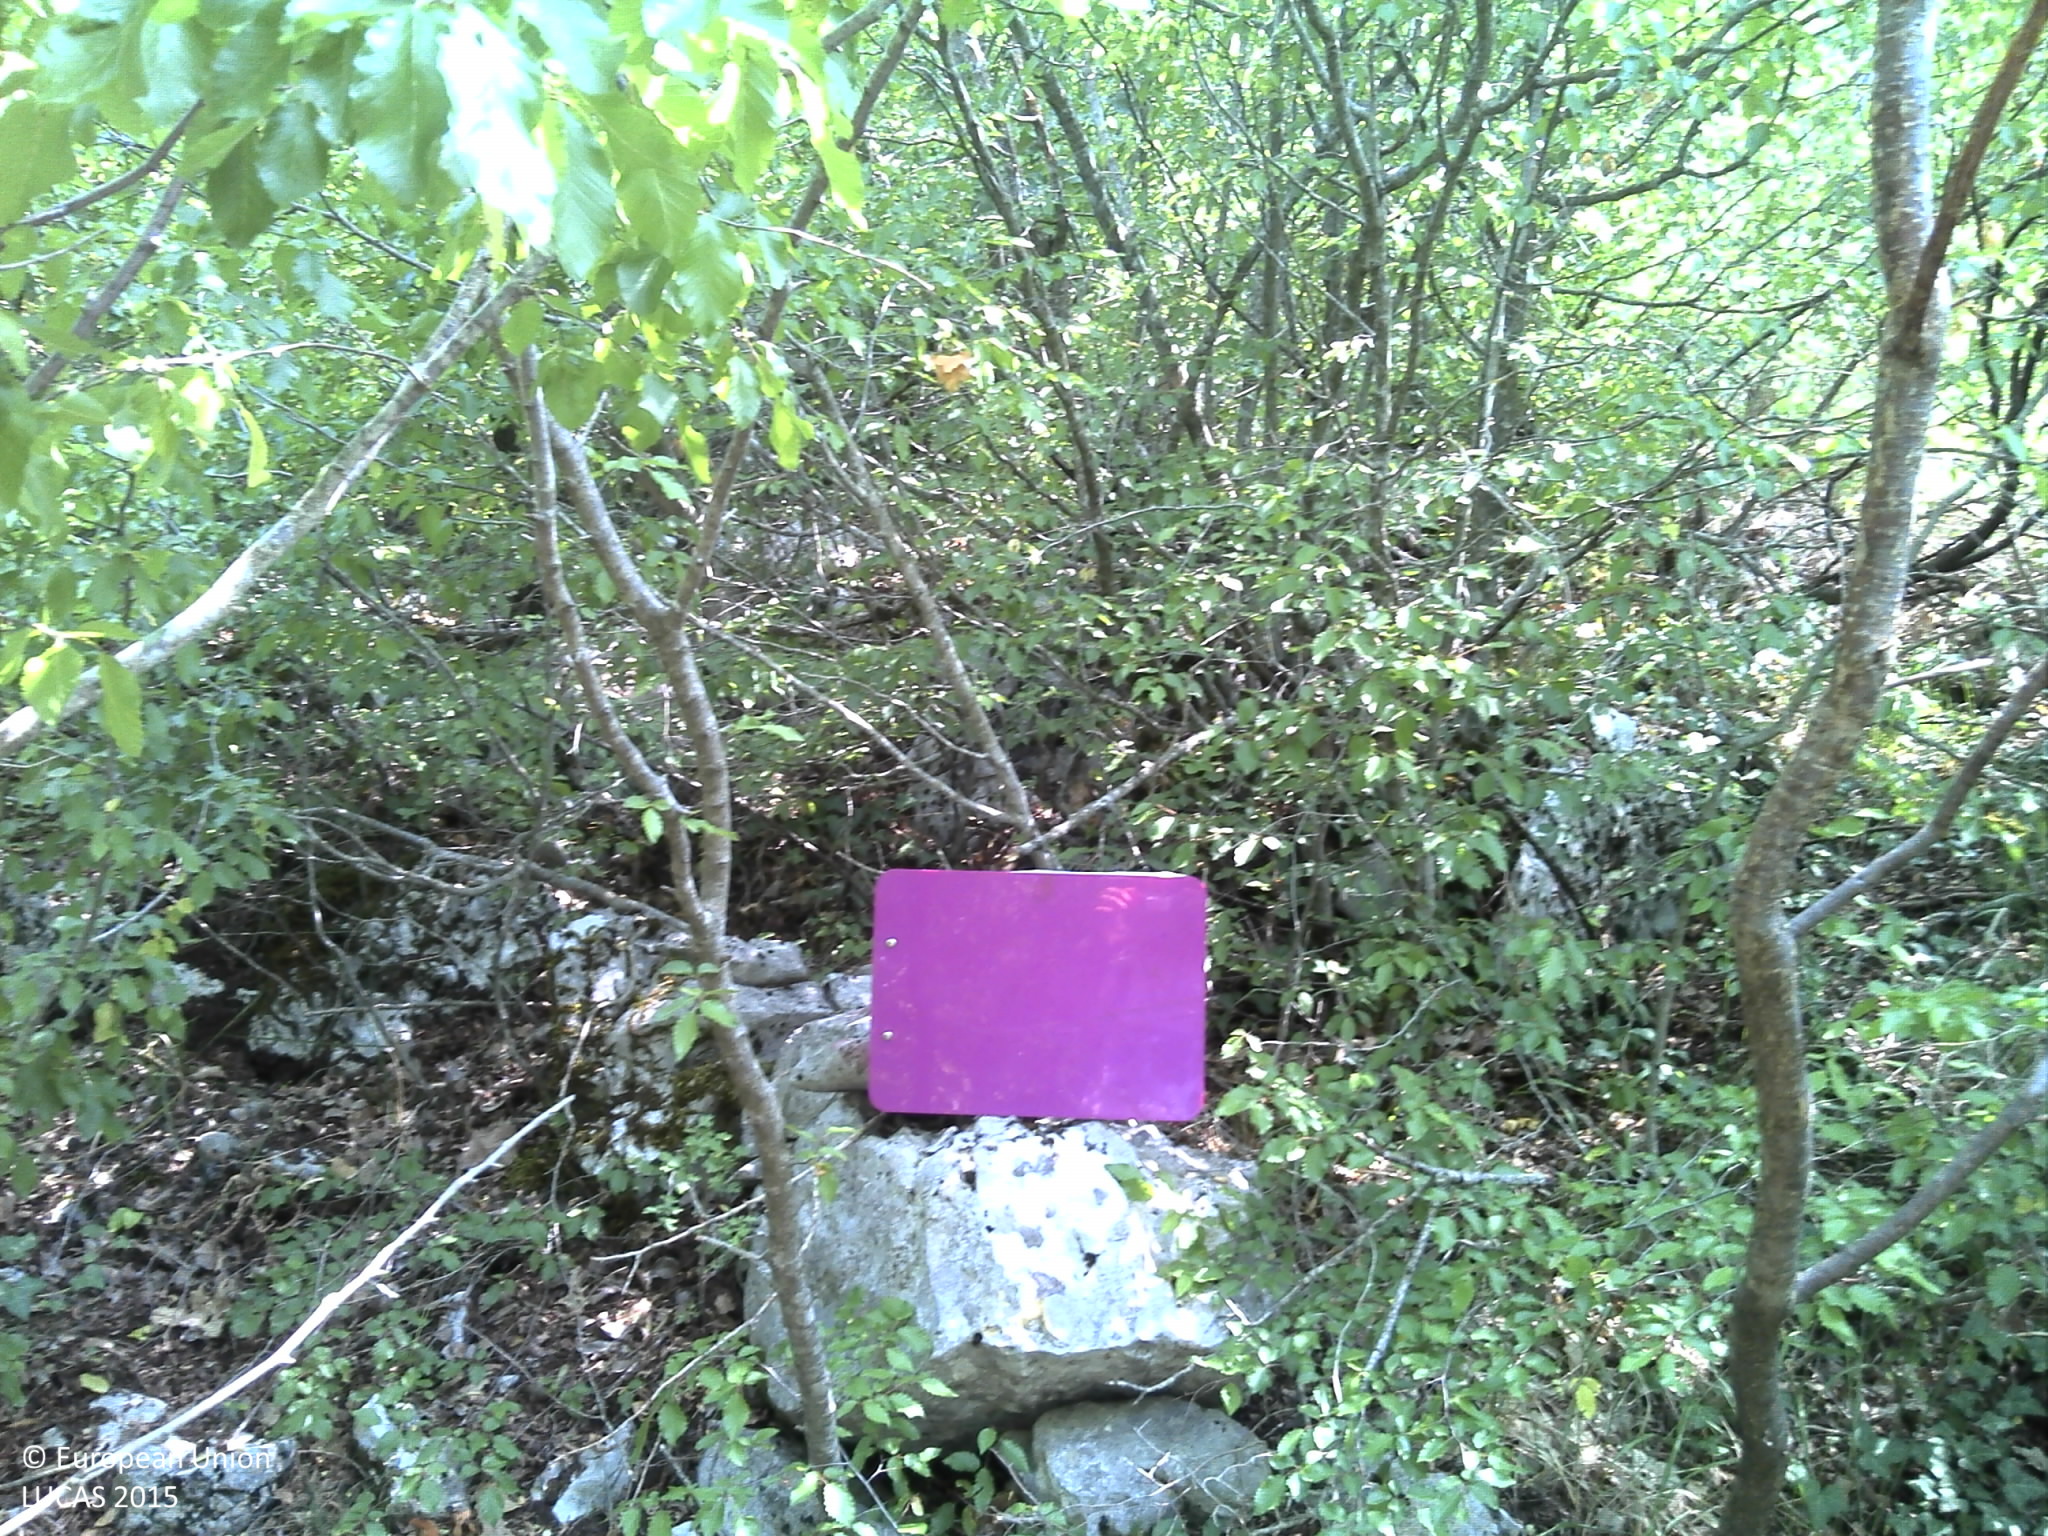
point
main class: Woodland
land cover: Broadleaved woodland
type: thermophilous deciduous forest
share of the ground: 50 - 75 %
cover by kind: broadleaved forest trees 65 %, shrubs 25 %, herbaceous plants 5 %, consolidated bare surface 5 %
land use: Semi-natural and natural areas not in use
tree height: > 5 m
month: July
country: HR
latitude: 43.5033
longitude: 16.9301
